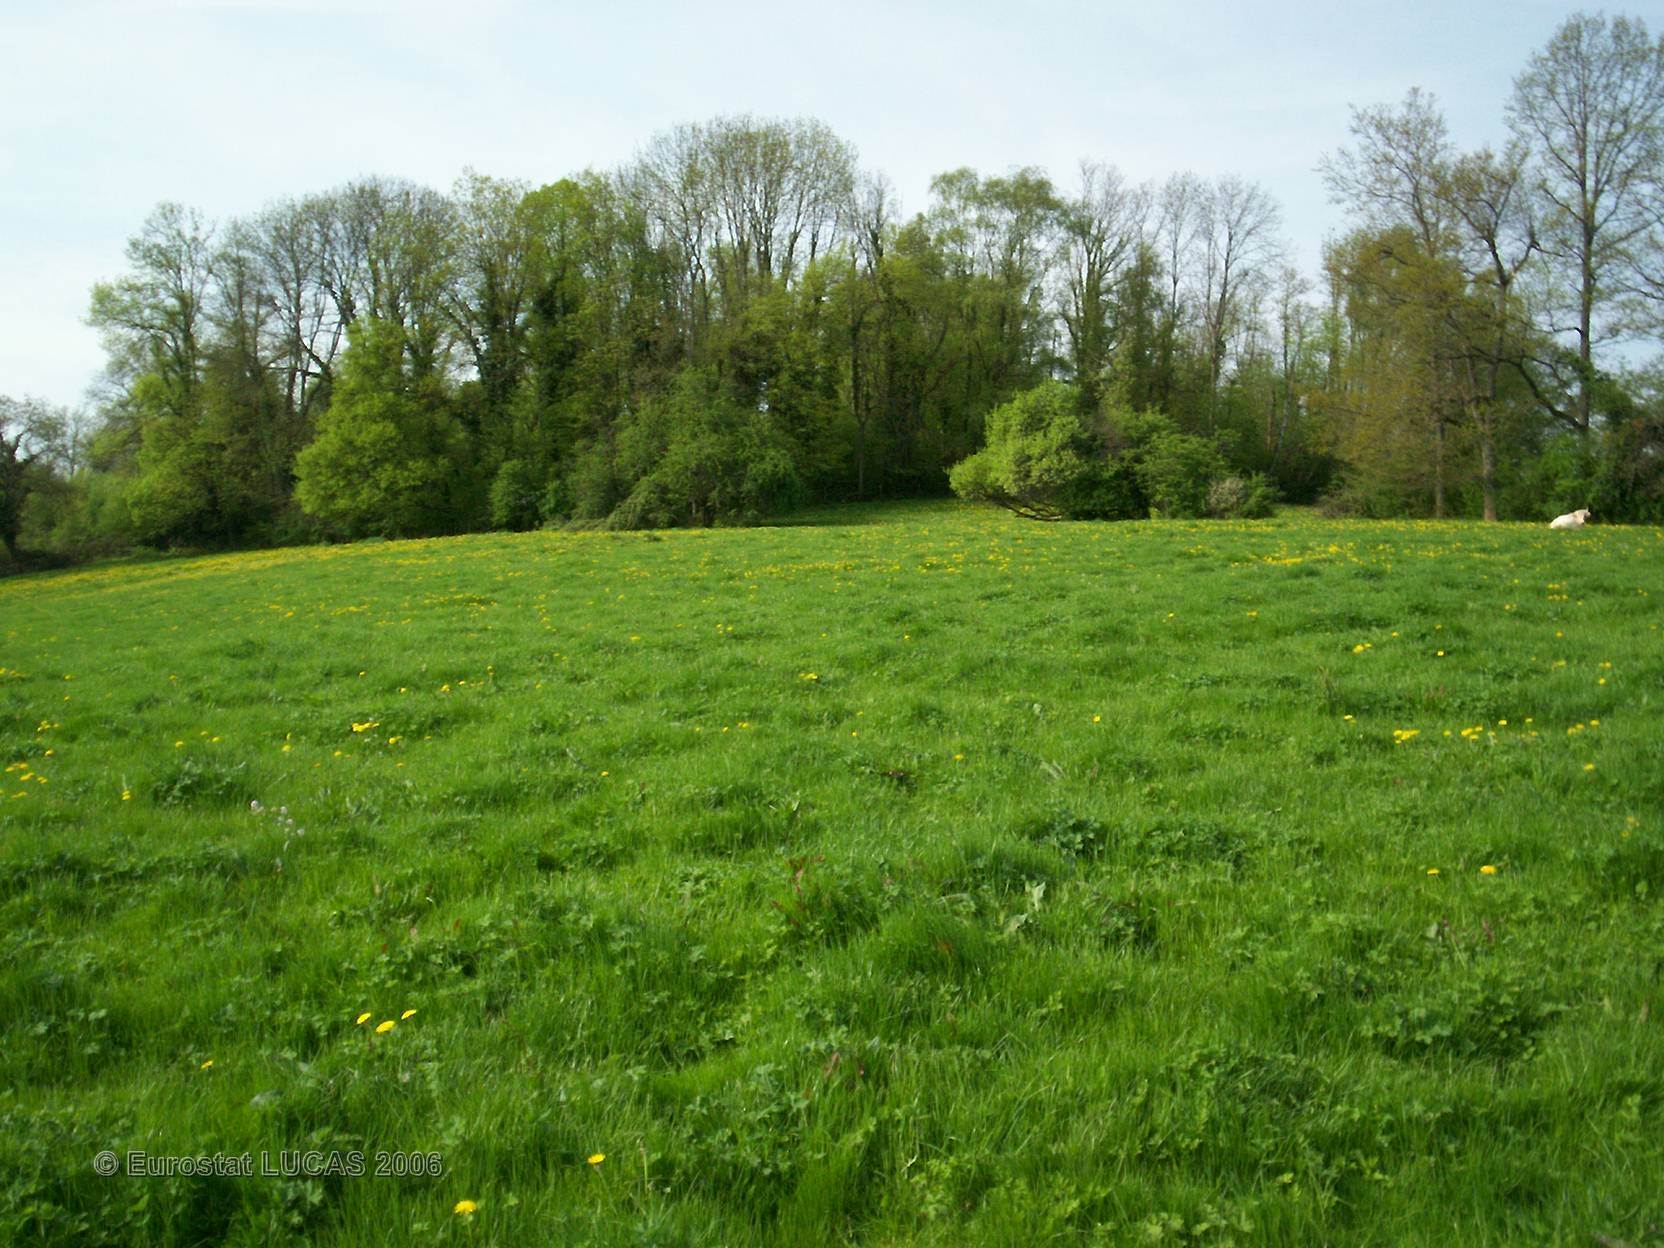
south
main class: Grassland
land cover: Grassland without tree/shrub cover
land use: Agriculture (excluding fallow land and kitchen gardens)
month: May
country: FR
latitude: 47.4074
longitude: 4.6325
